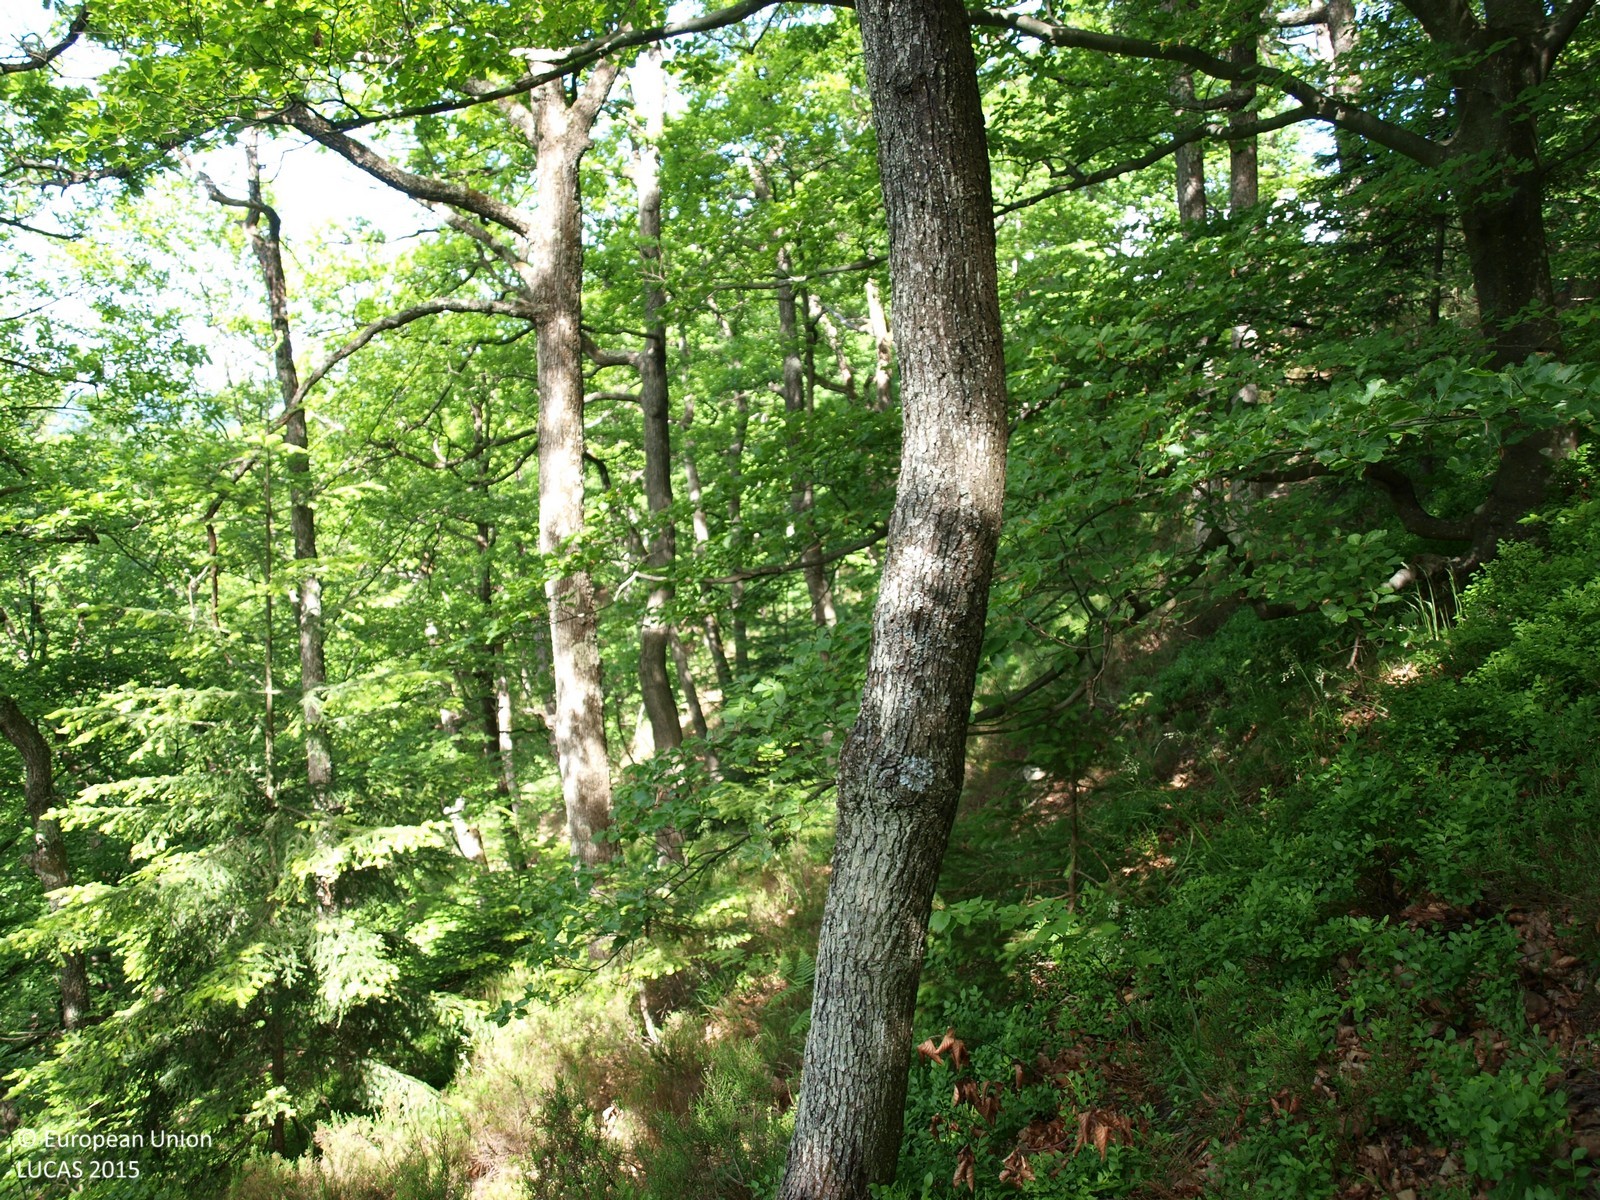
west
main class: Woodland
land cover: Broadleaved woodland
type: mesophytic deciduous forest
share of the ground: > 75 %
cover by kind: broadleaved forest trees 100 %
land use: Forestry
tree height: > 5 m
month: May
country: HR
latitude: 46.2605
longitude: 15.9018
